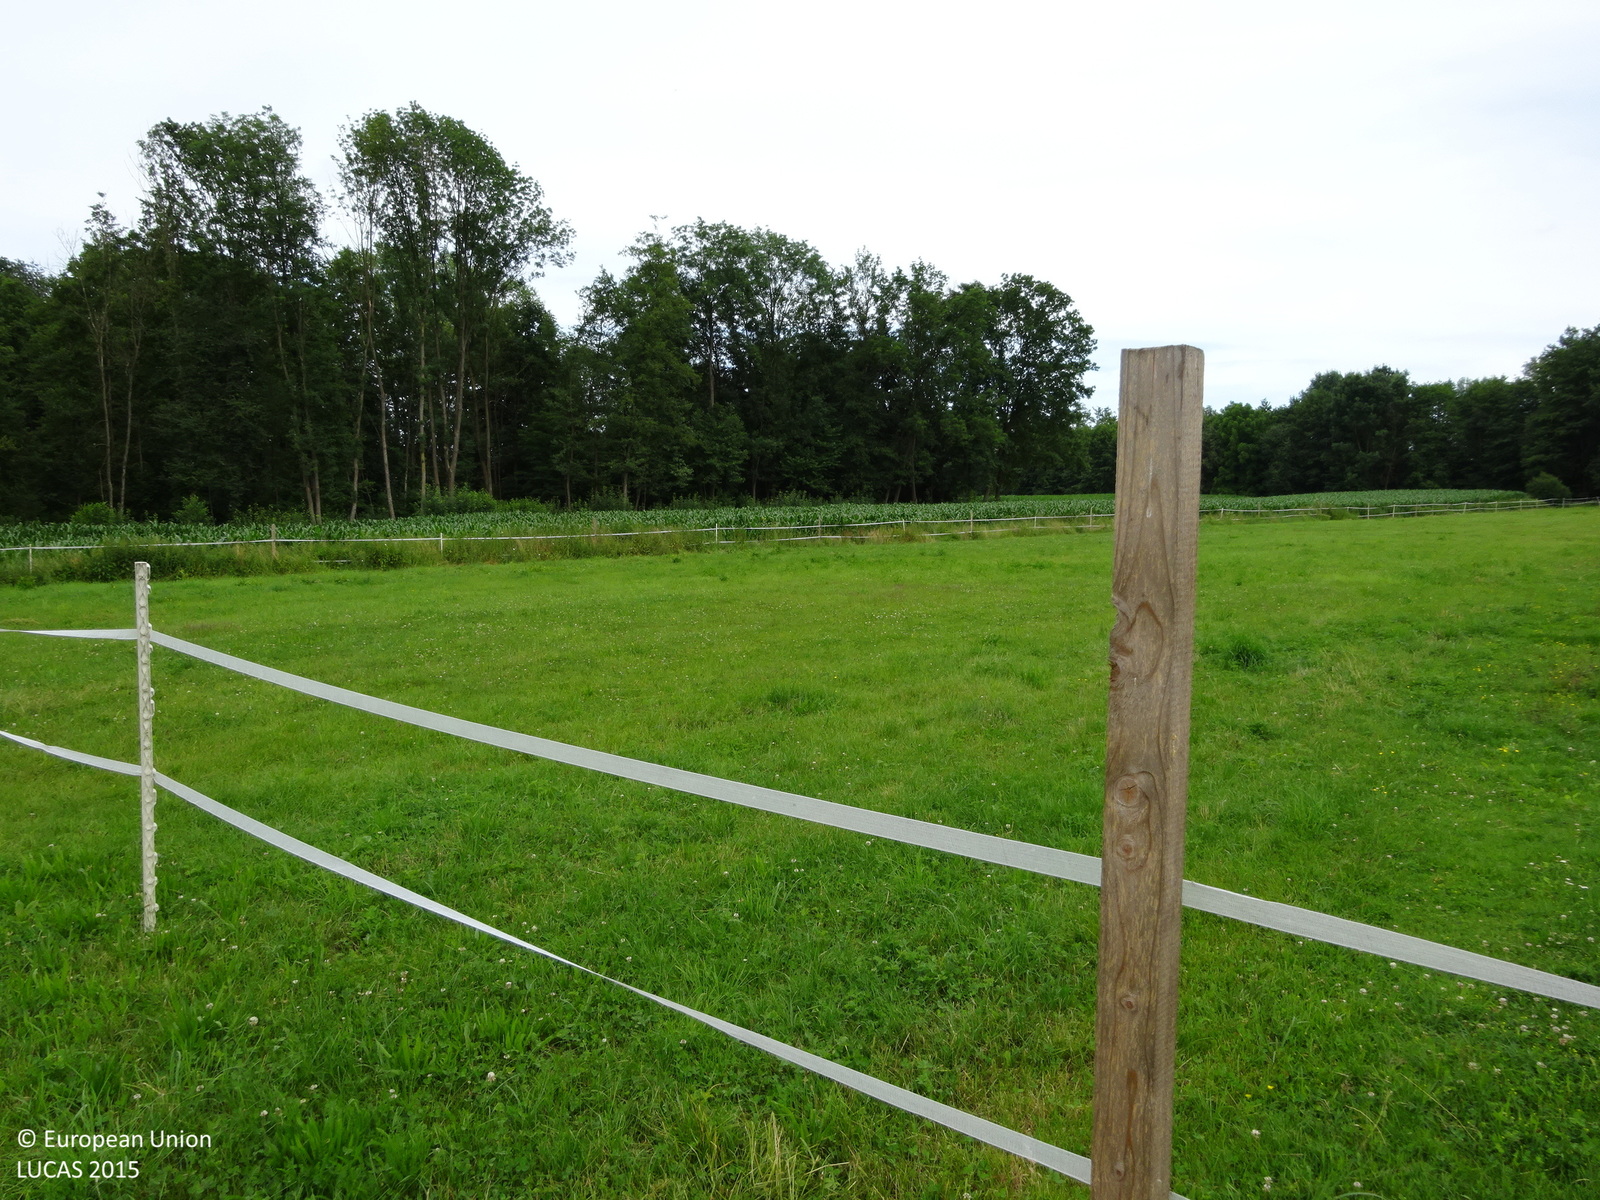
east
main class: Grassland
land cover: Grassland without tree/shrub cover
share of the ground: > 75 %
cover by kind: herbaceous plants 100 %
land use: Agriculture (excluding fallow land and kitchen gardens)
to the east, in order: Grassland without tree/shrub cover; Fences; Grass margins; Maize; Grassland without tree/shrub cover; Broadleaved woodland; Tracks; Broadleaved woodland; Tracks; Broadleaved woodland; Common wheat; Maize
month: June
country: AT
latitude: 46.7273
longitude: 15.6128
